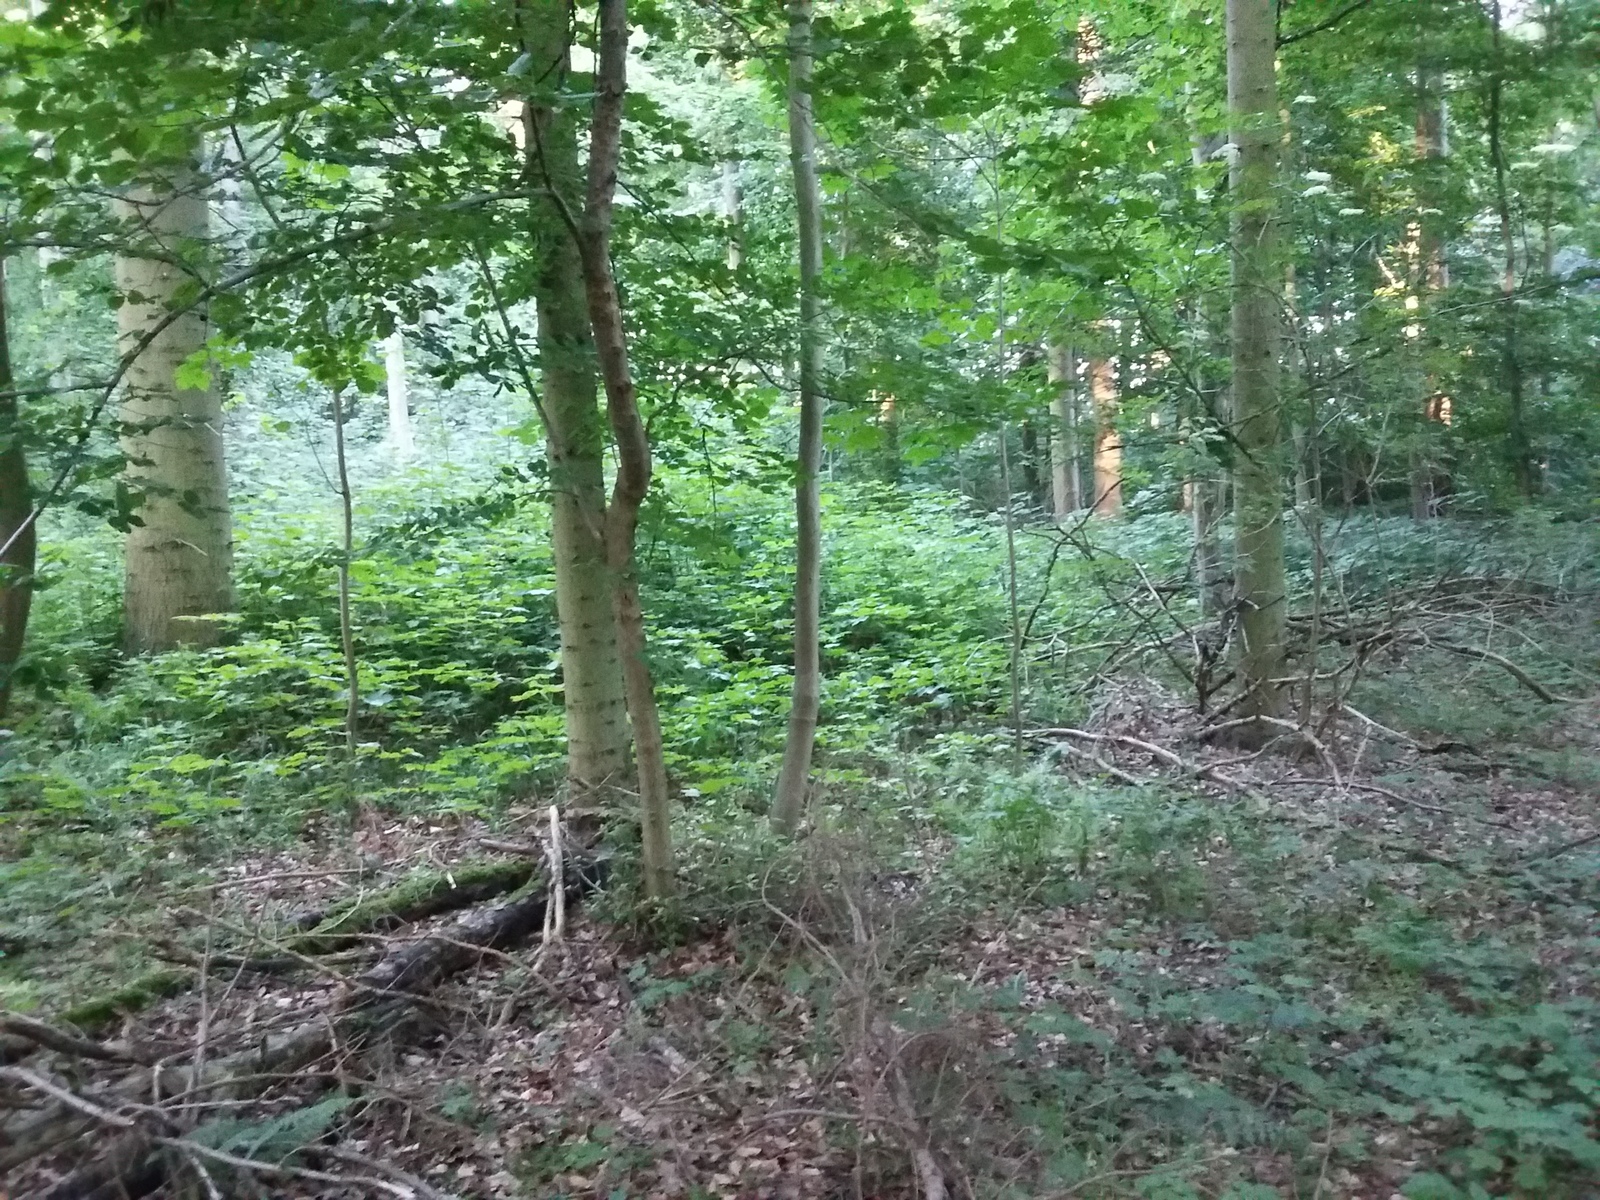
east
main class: Woodland
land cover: Spruce dominated mixed woodland
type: thermophilous deciduous forest
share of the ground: > 75 %
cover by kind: coniferous forest trees 65 %, broadleaved forest trees 25 %, herbaceous plants 10 %
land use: Forestry
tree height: > 5 m
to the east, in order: Spruce dominated mixed woodland; Broadleaved woodland; Ditches and canals; Broadleaved woodland; Common wheat
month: July
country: DK
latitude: 54.9673
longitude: 12.0137
